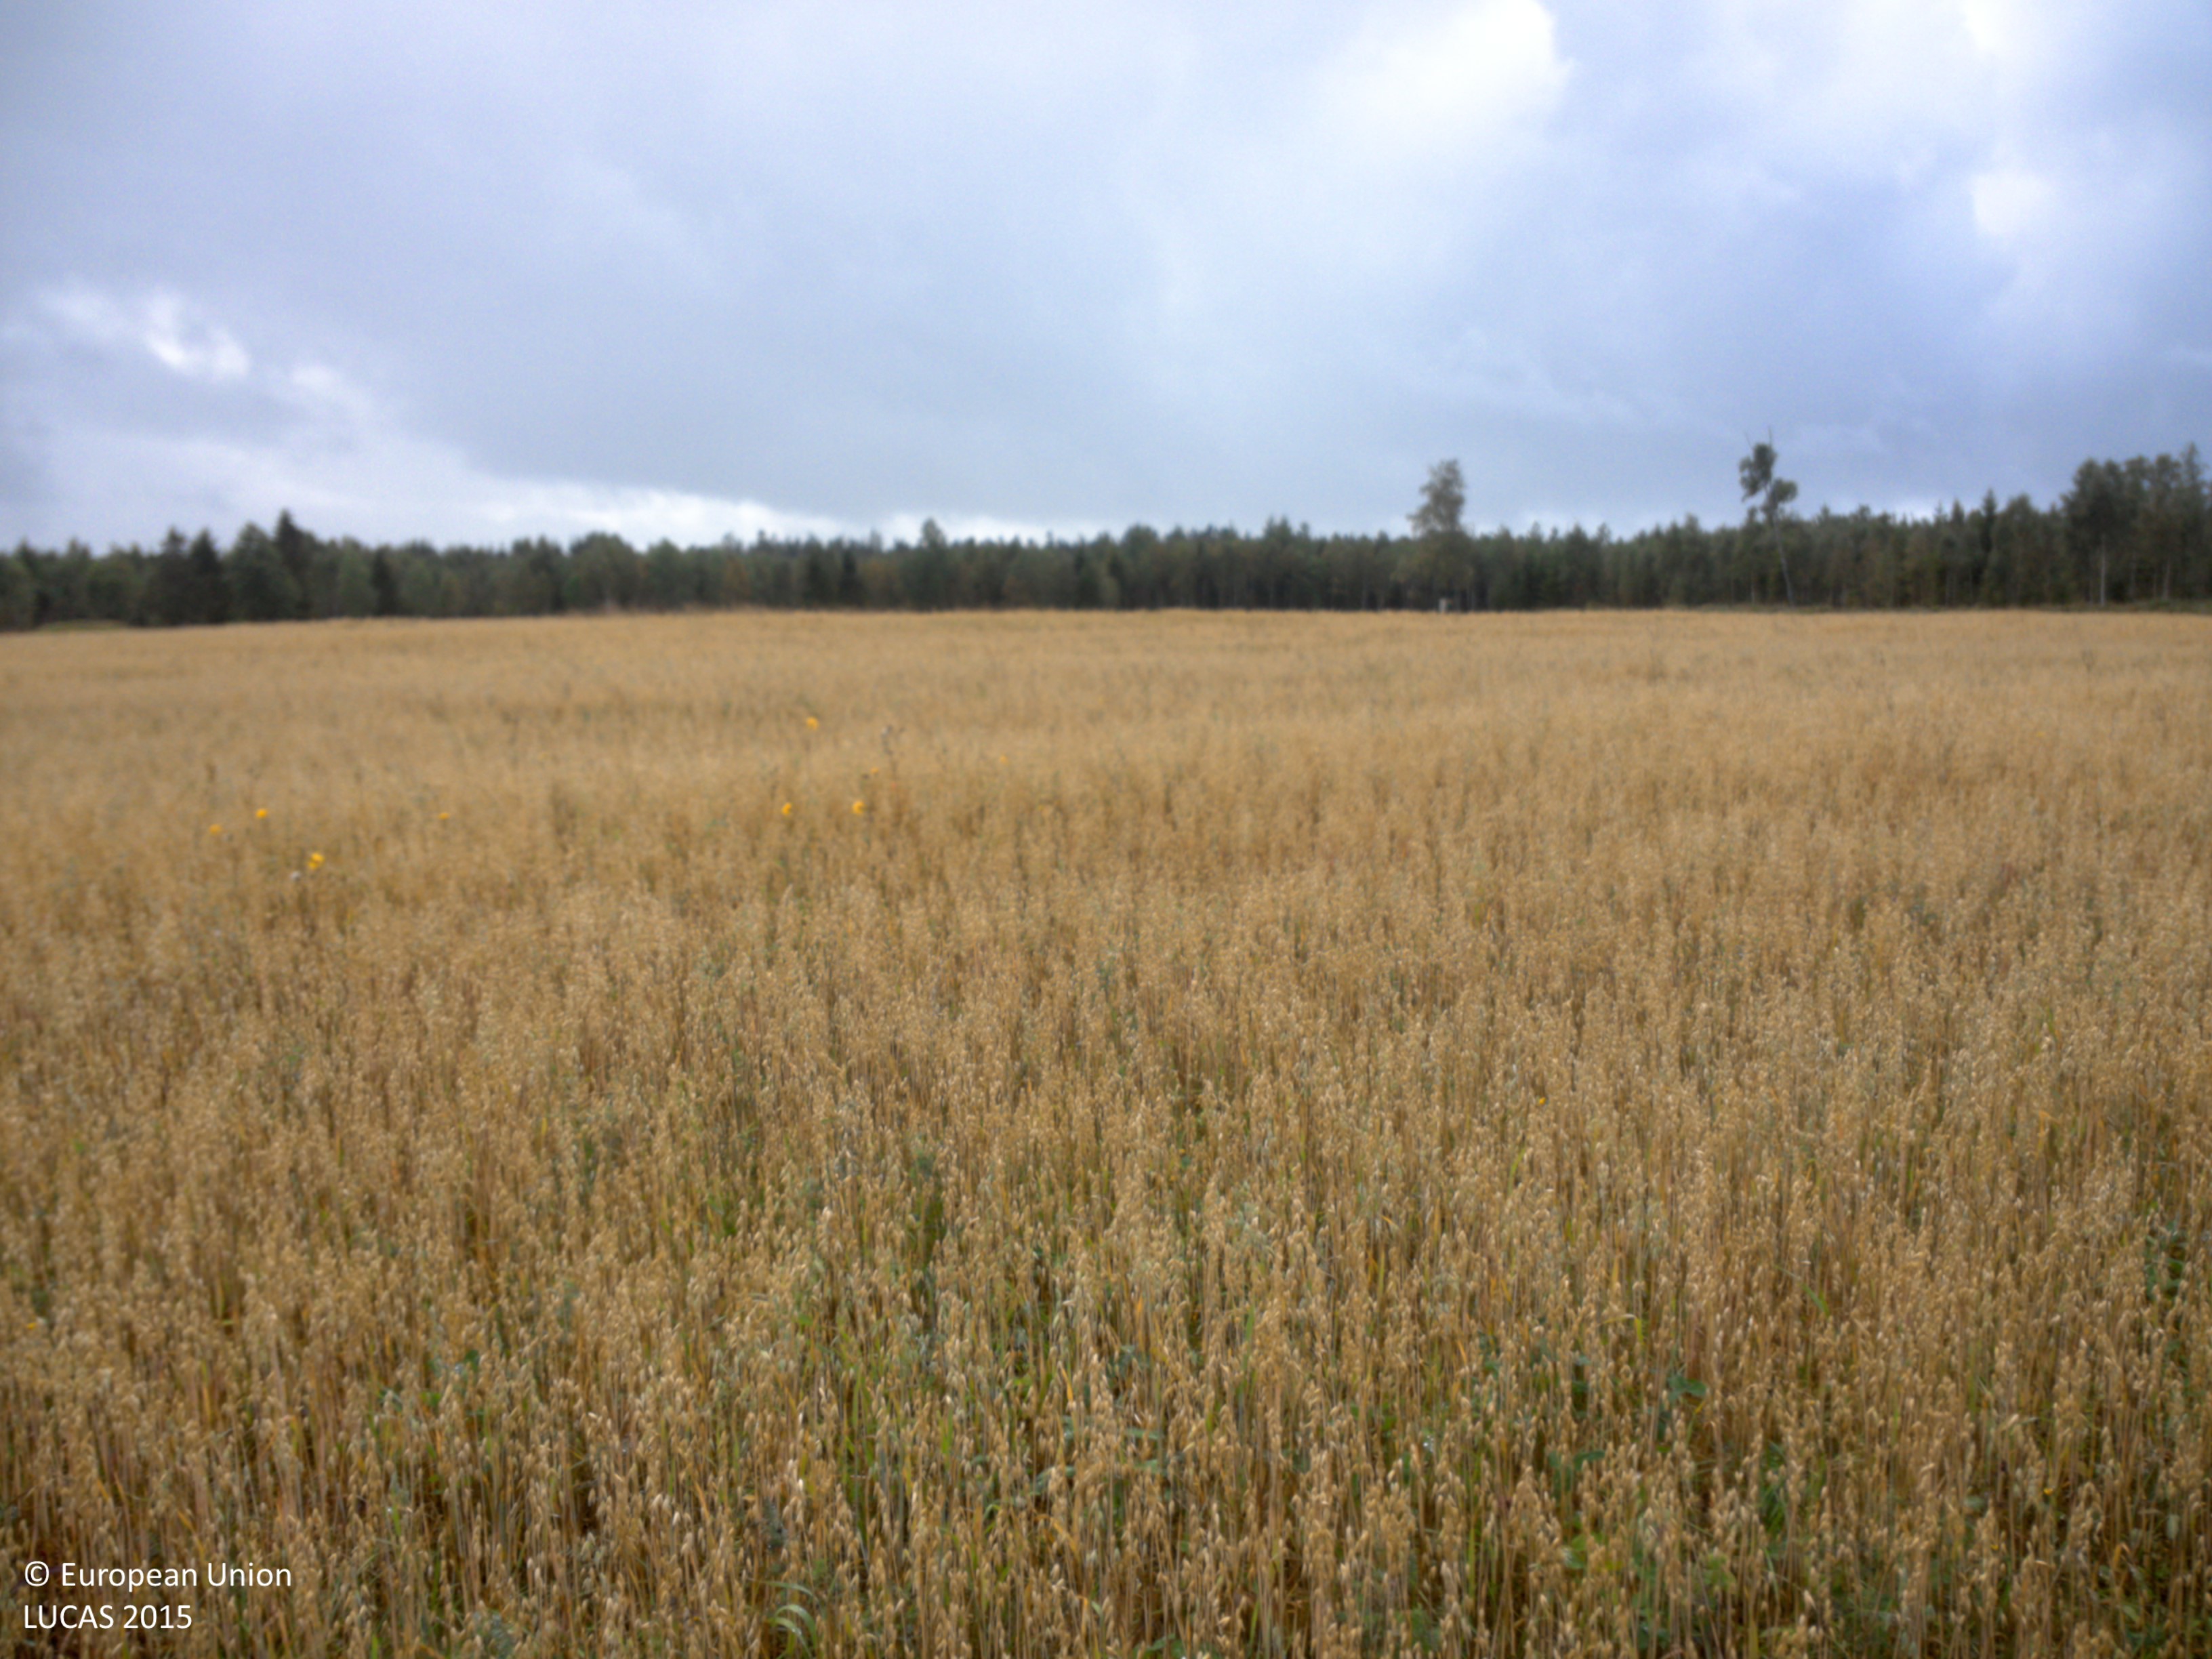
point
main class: Cropland
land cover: Oats
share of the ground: > 75 %
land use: Agriculture (excluding fallow land and kitchen gardens)
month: August
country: SE
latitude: 58.3449
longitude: 12.2336
